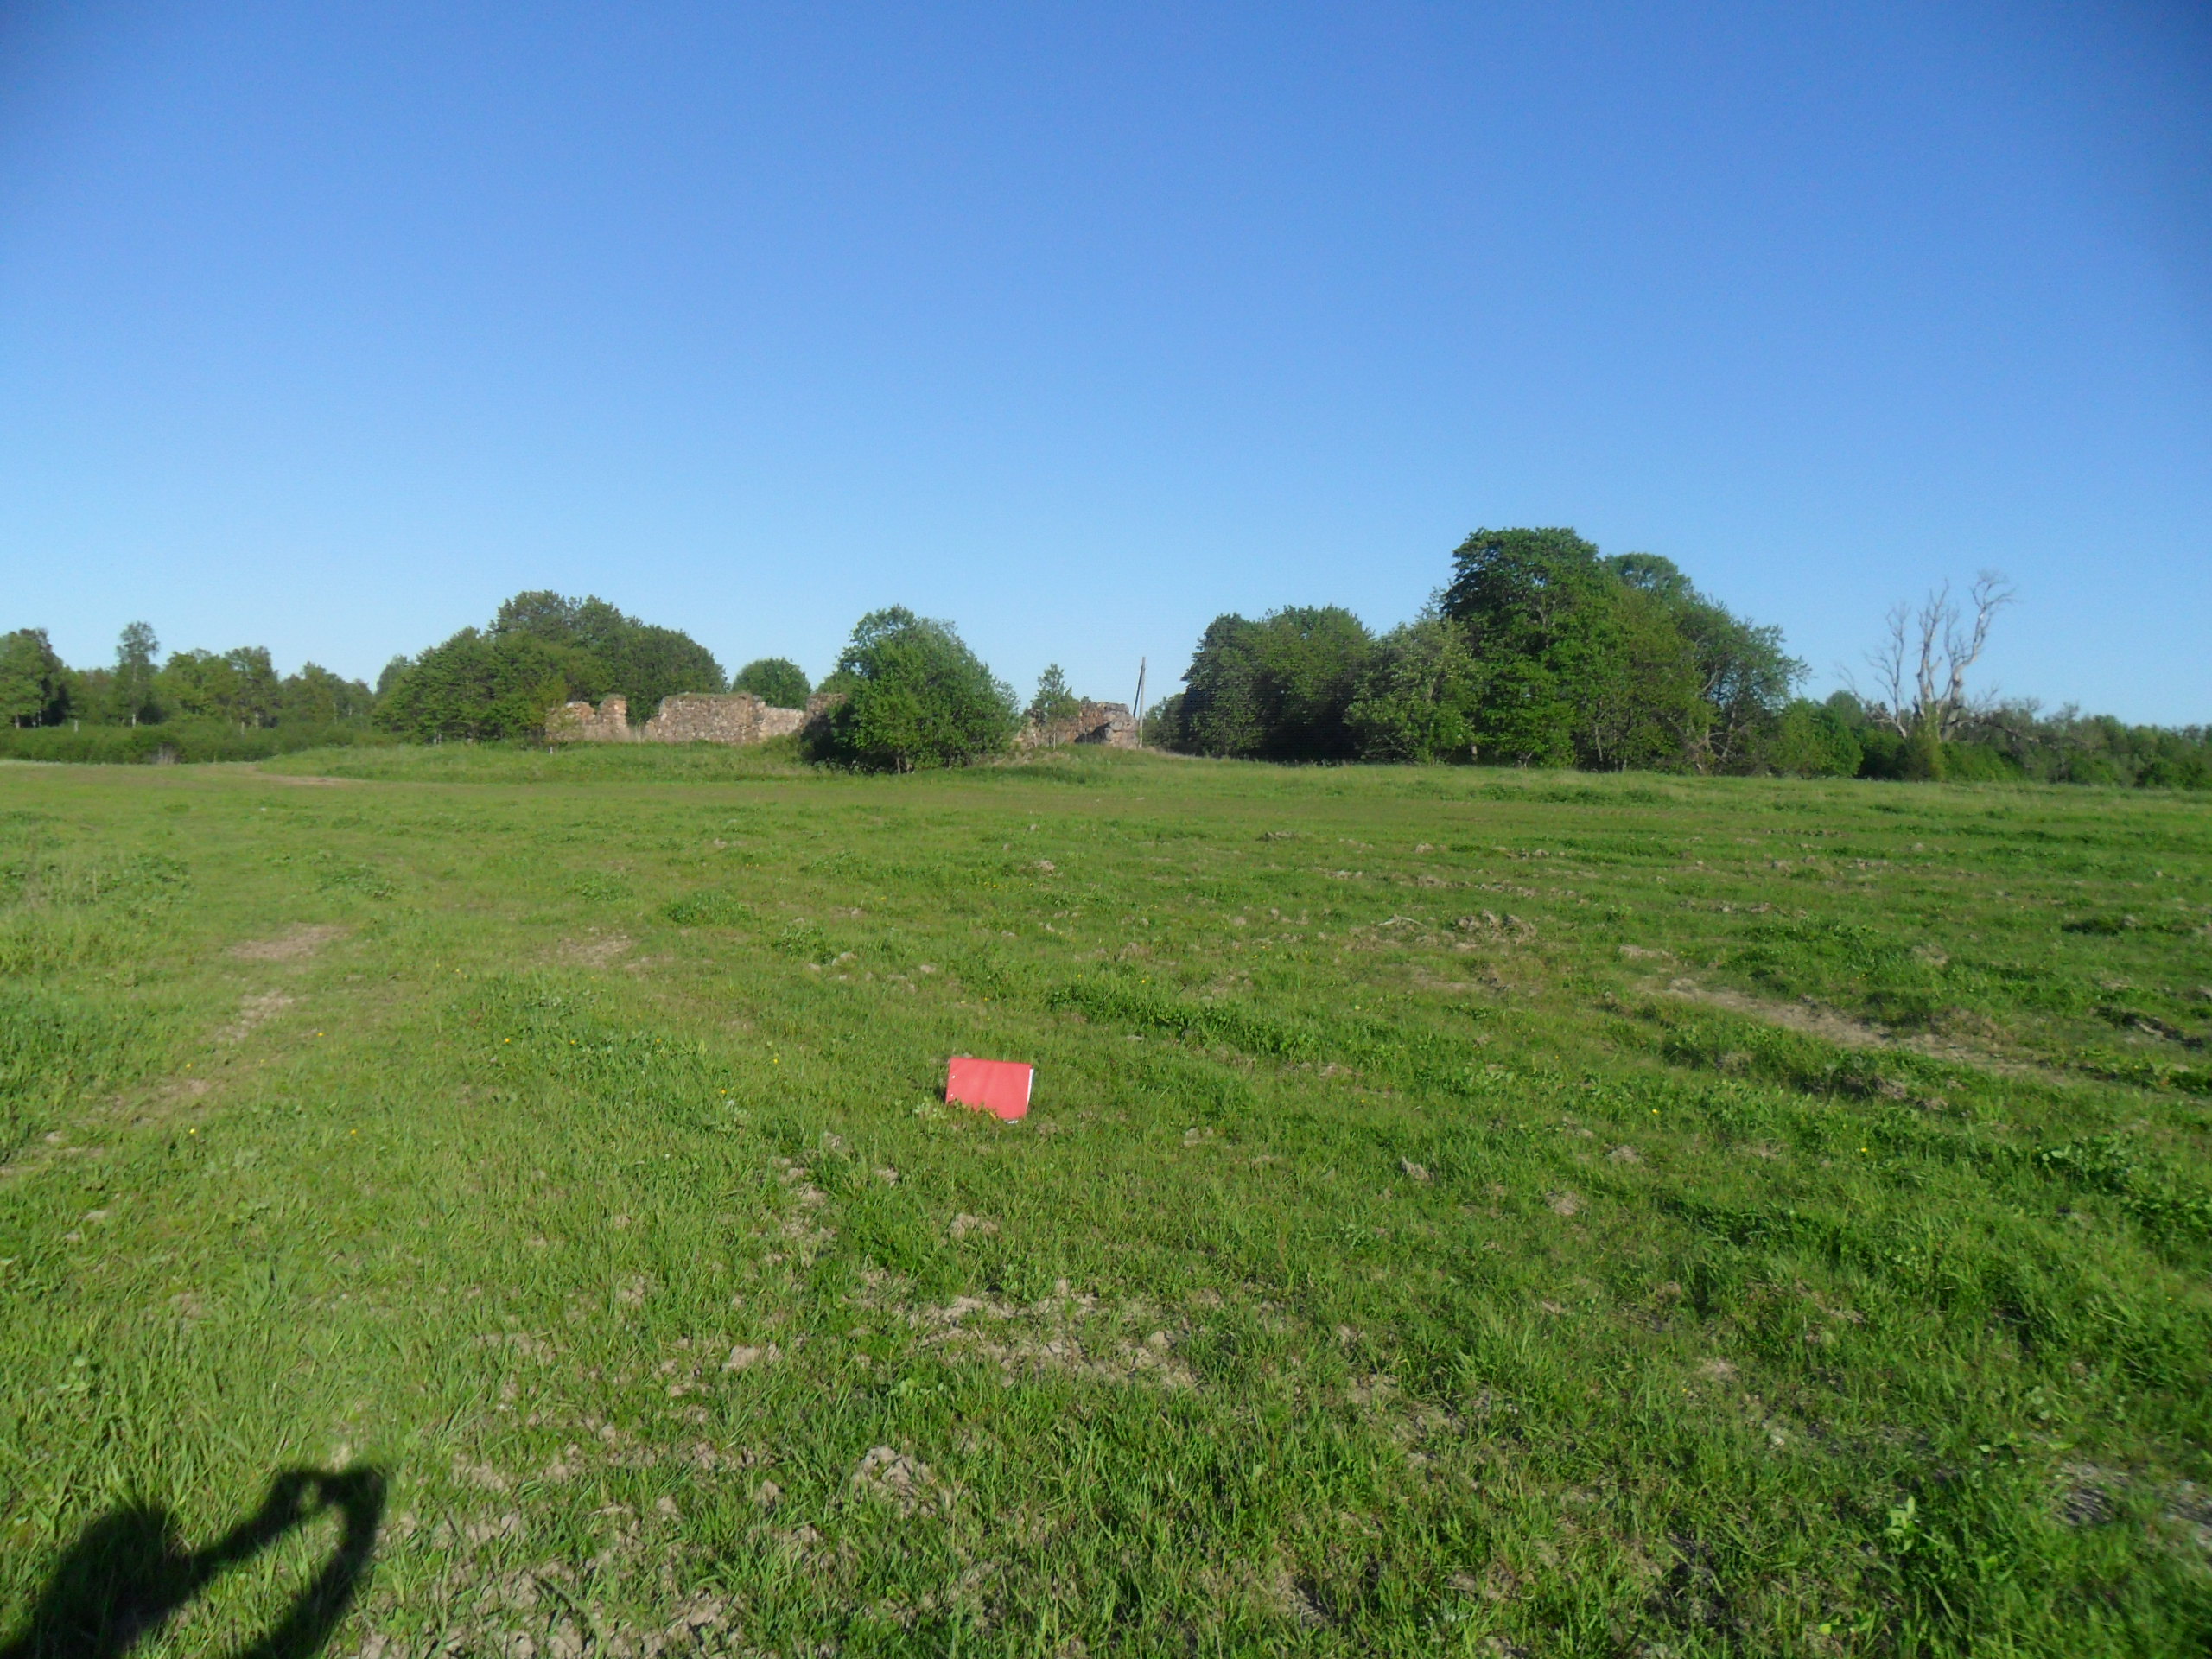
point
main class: Grassland
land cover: Grassland without tree/shrub cover
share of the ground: > 75 %
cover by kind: herbaceous plants 85 %, unconsolidated bare surface 5 %
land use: Agriculture (excluding fallow land and kitchen gardens)
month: June
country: LV
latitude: 57.5752
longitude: 22.3402
